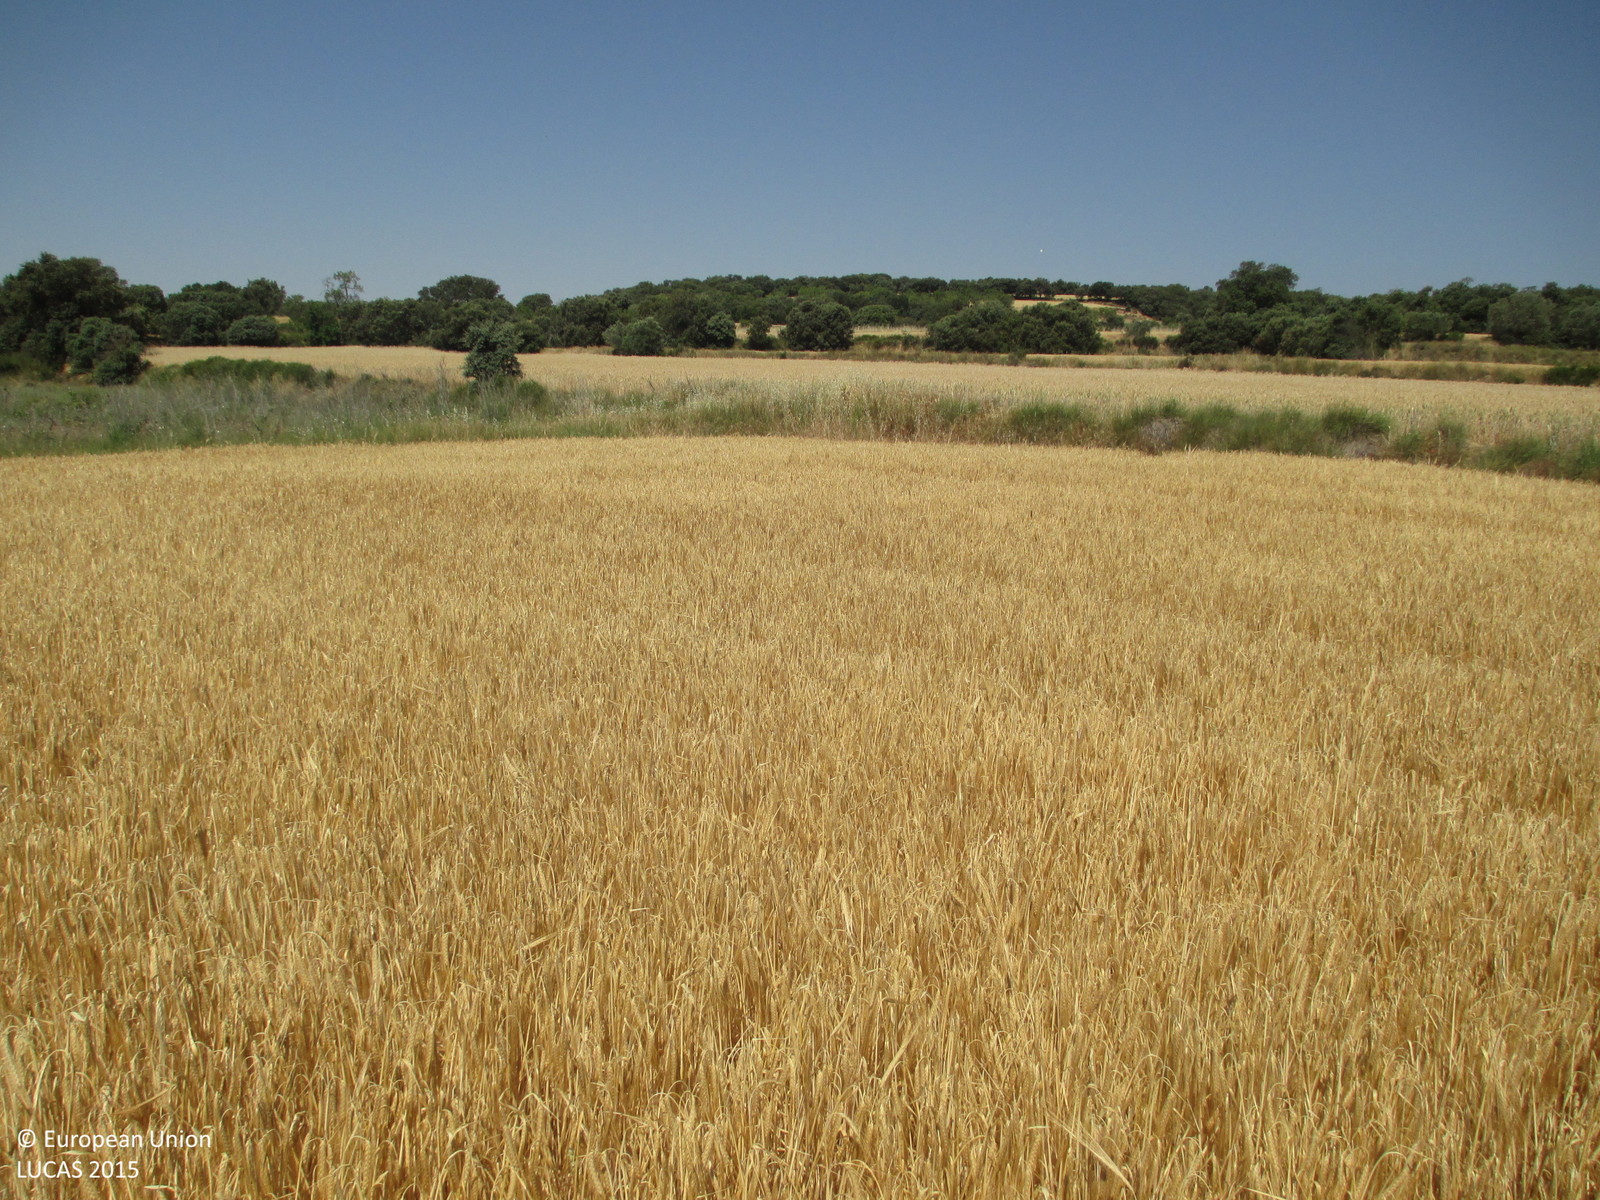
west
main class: Cropland
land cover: Barley
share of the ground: > 75 %
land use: Agriculture (excluding fallow land and kitchen gardens)
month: June
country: ES
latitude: 42.1561
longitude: -0.1994
